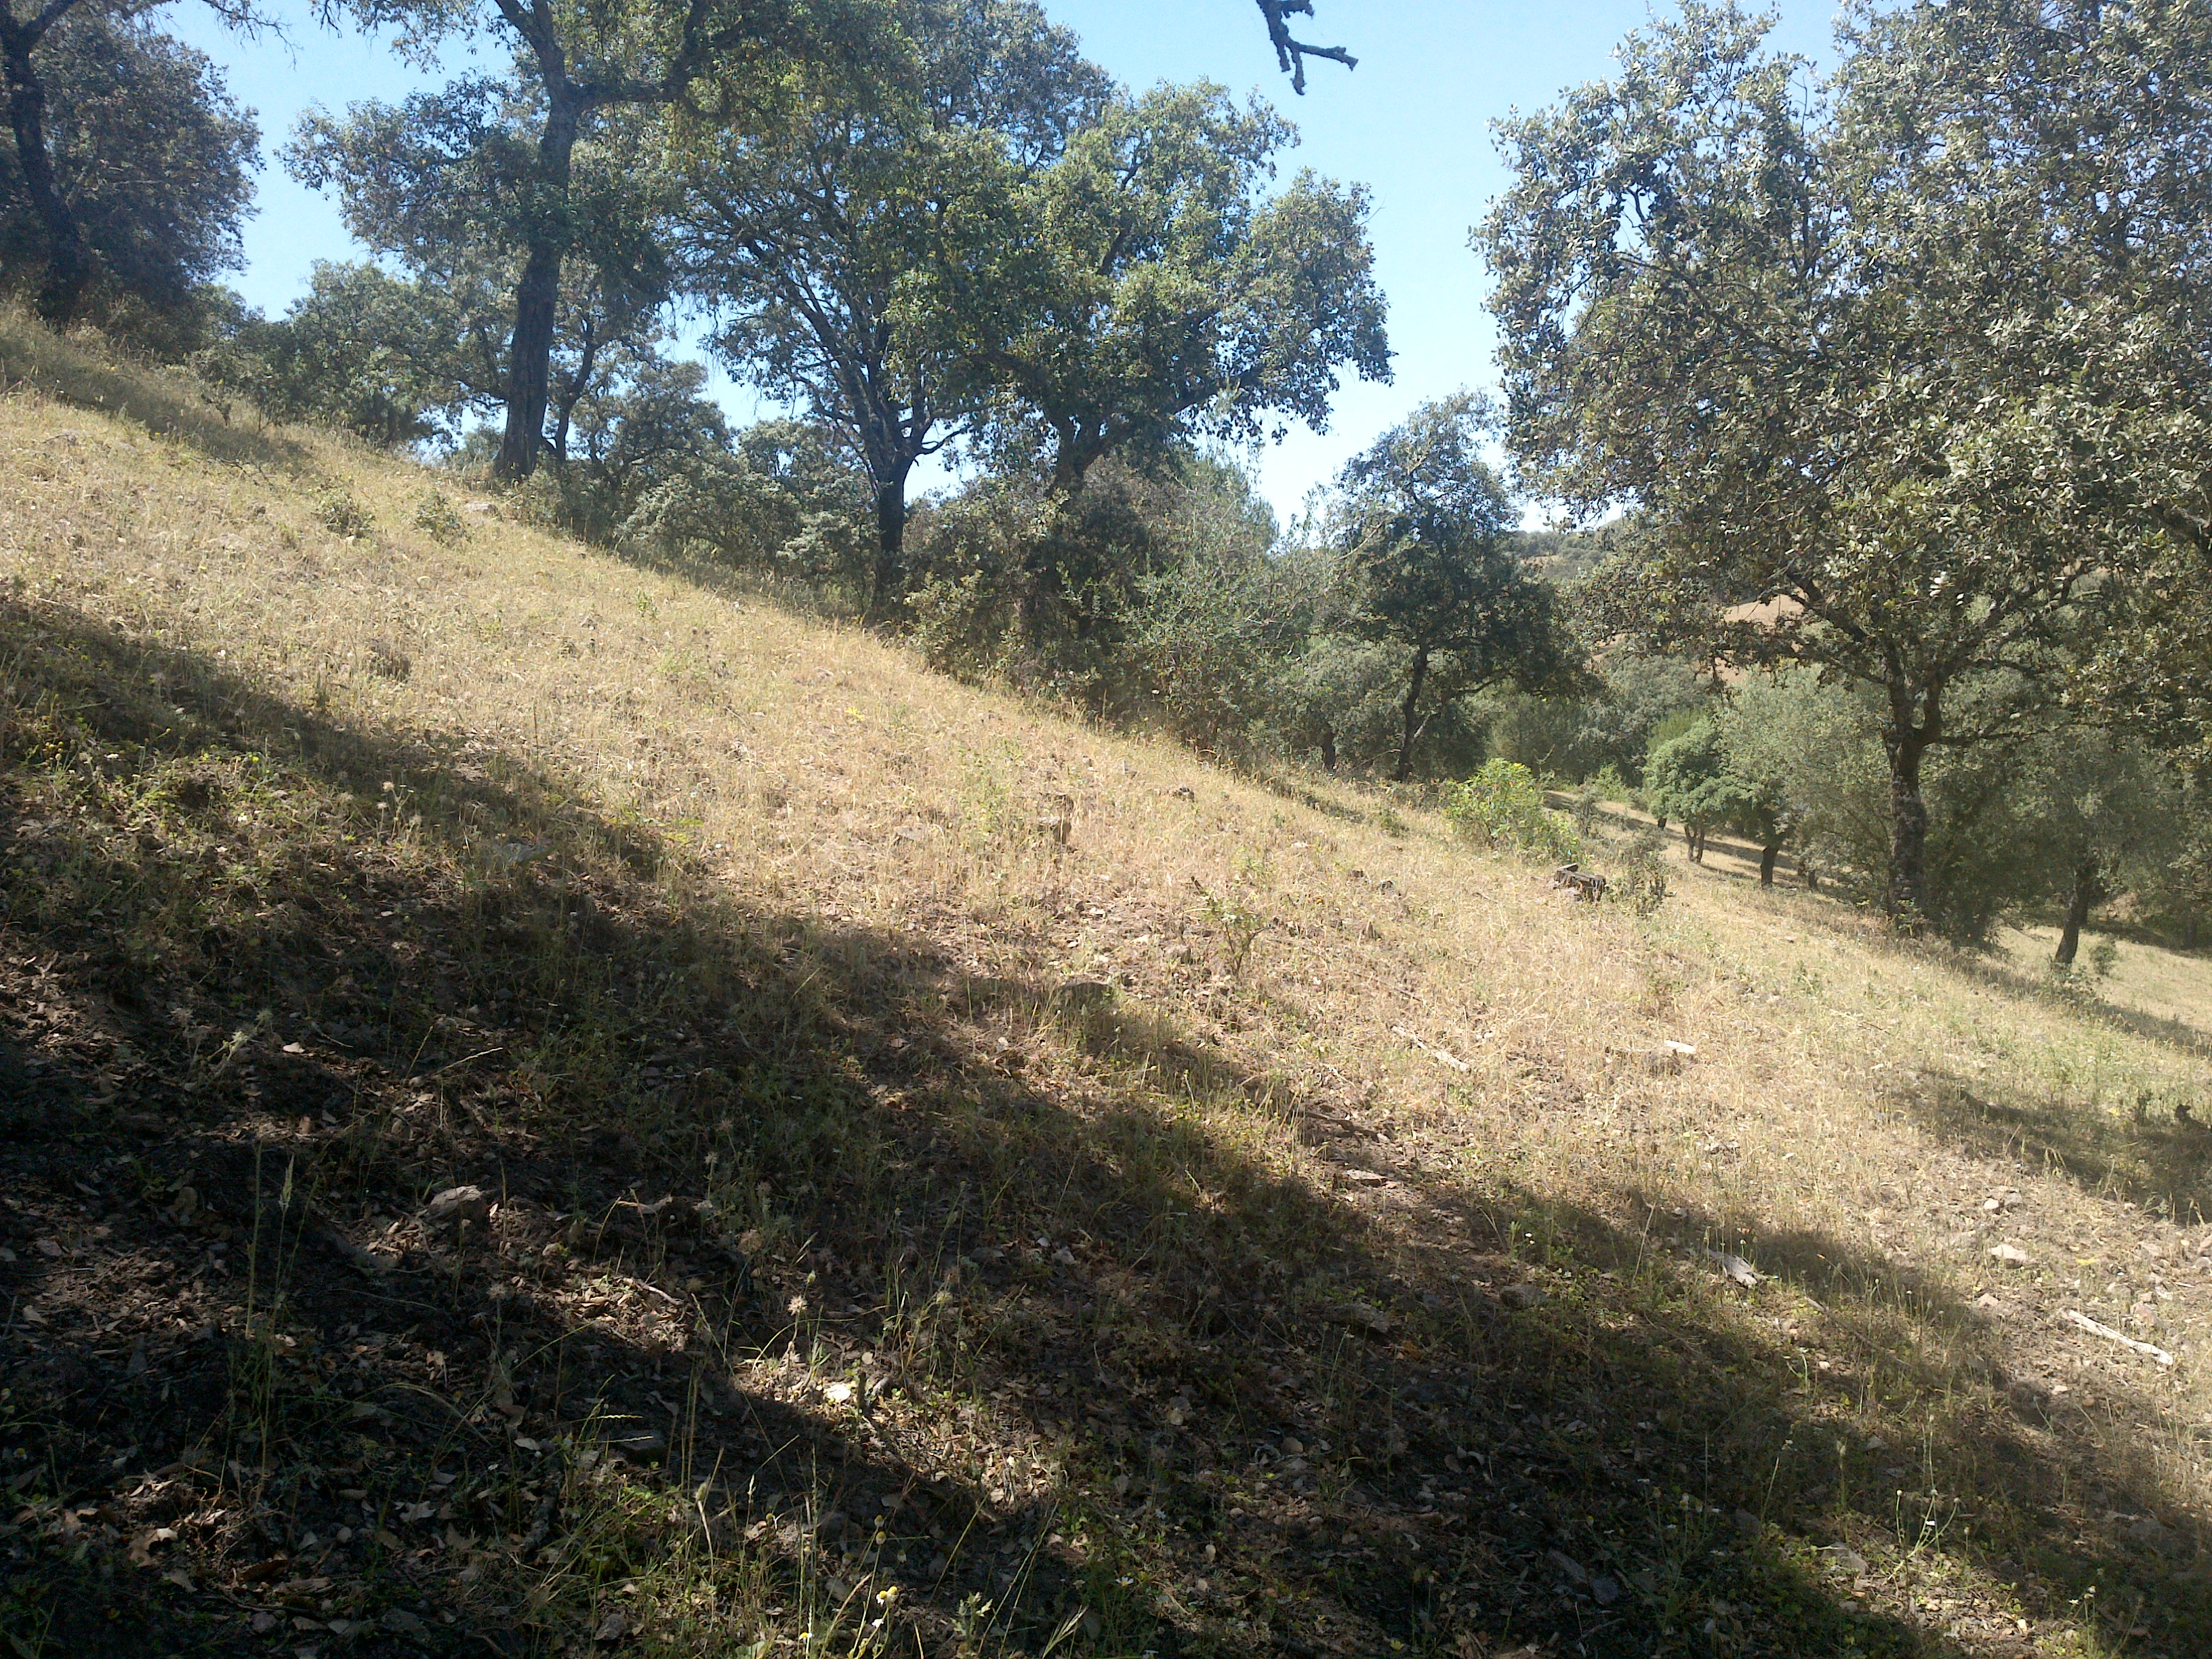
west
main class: Woodland
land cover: Broadleaved woodland
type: broadleaved evergreen forest
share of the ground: 50 - 75 %
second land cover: Spontaneously vegetated surfaces
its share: 10 - 25 %
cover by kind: broadleaved forest trees 60 %, shrubs 10 %, herbaceous plants 10 %, lichens and mosses 10 %, unconsolidated bare surface 10 %
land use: Forestry
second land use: Agriculture (excluding fallow land and kitchen gardens)
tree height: > 5 m
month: May
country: ES
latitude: 37.9195
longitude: -4.9534
